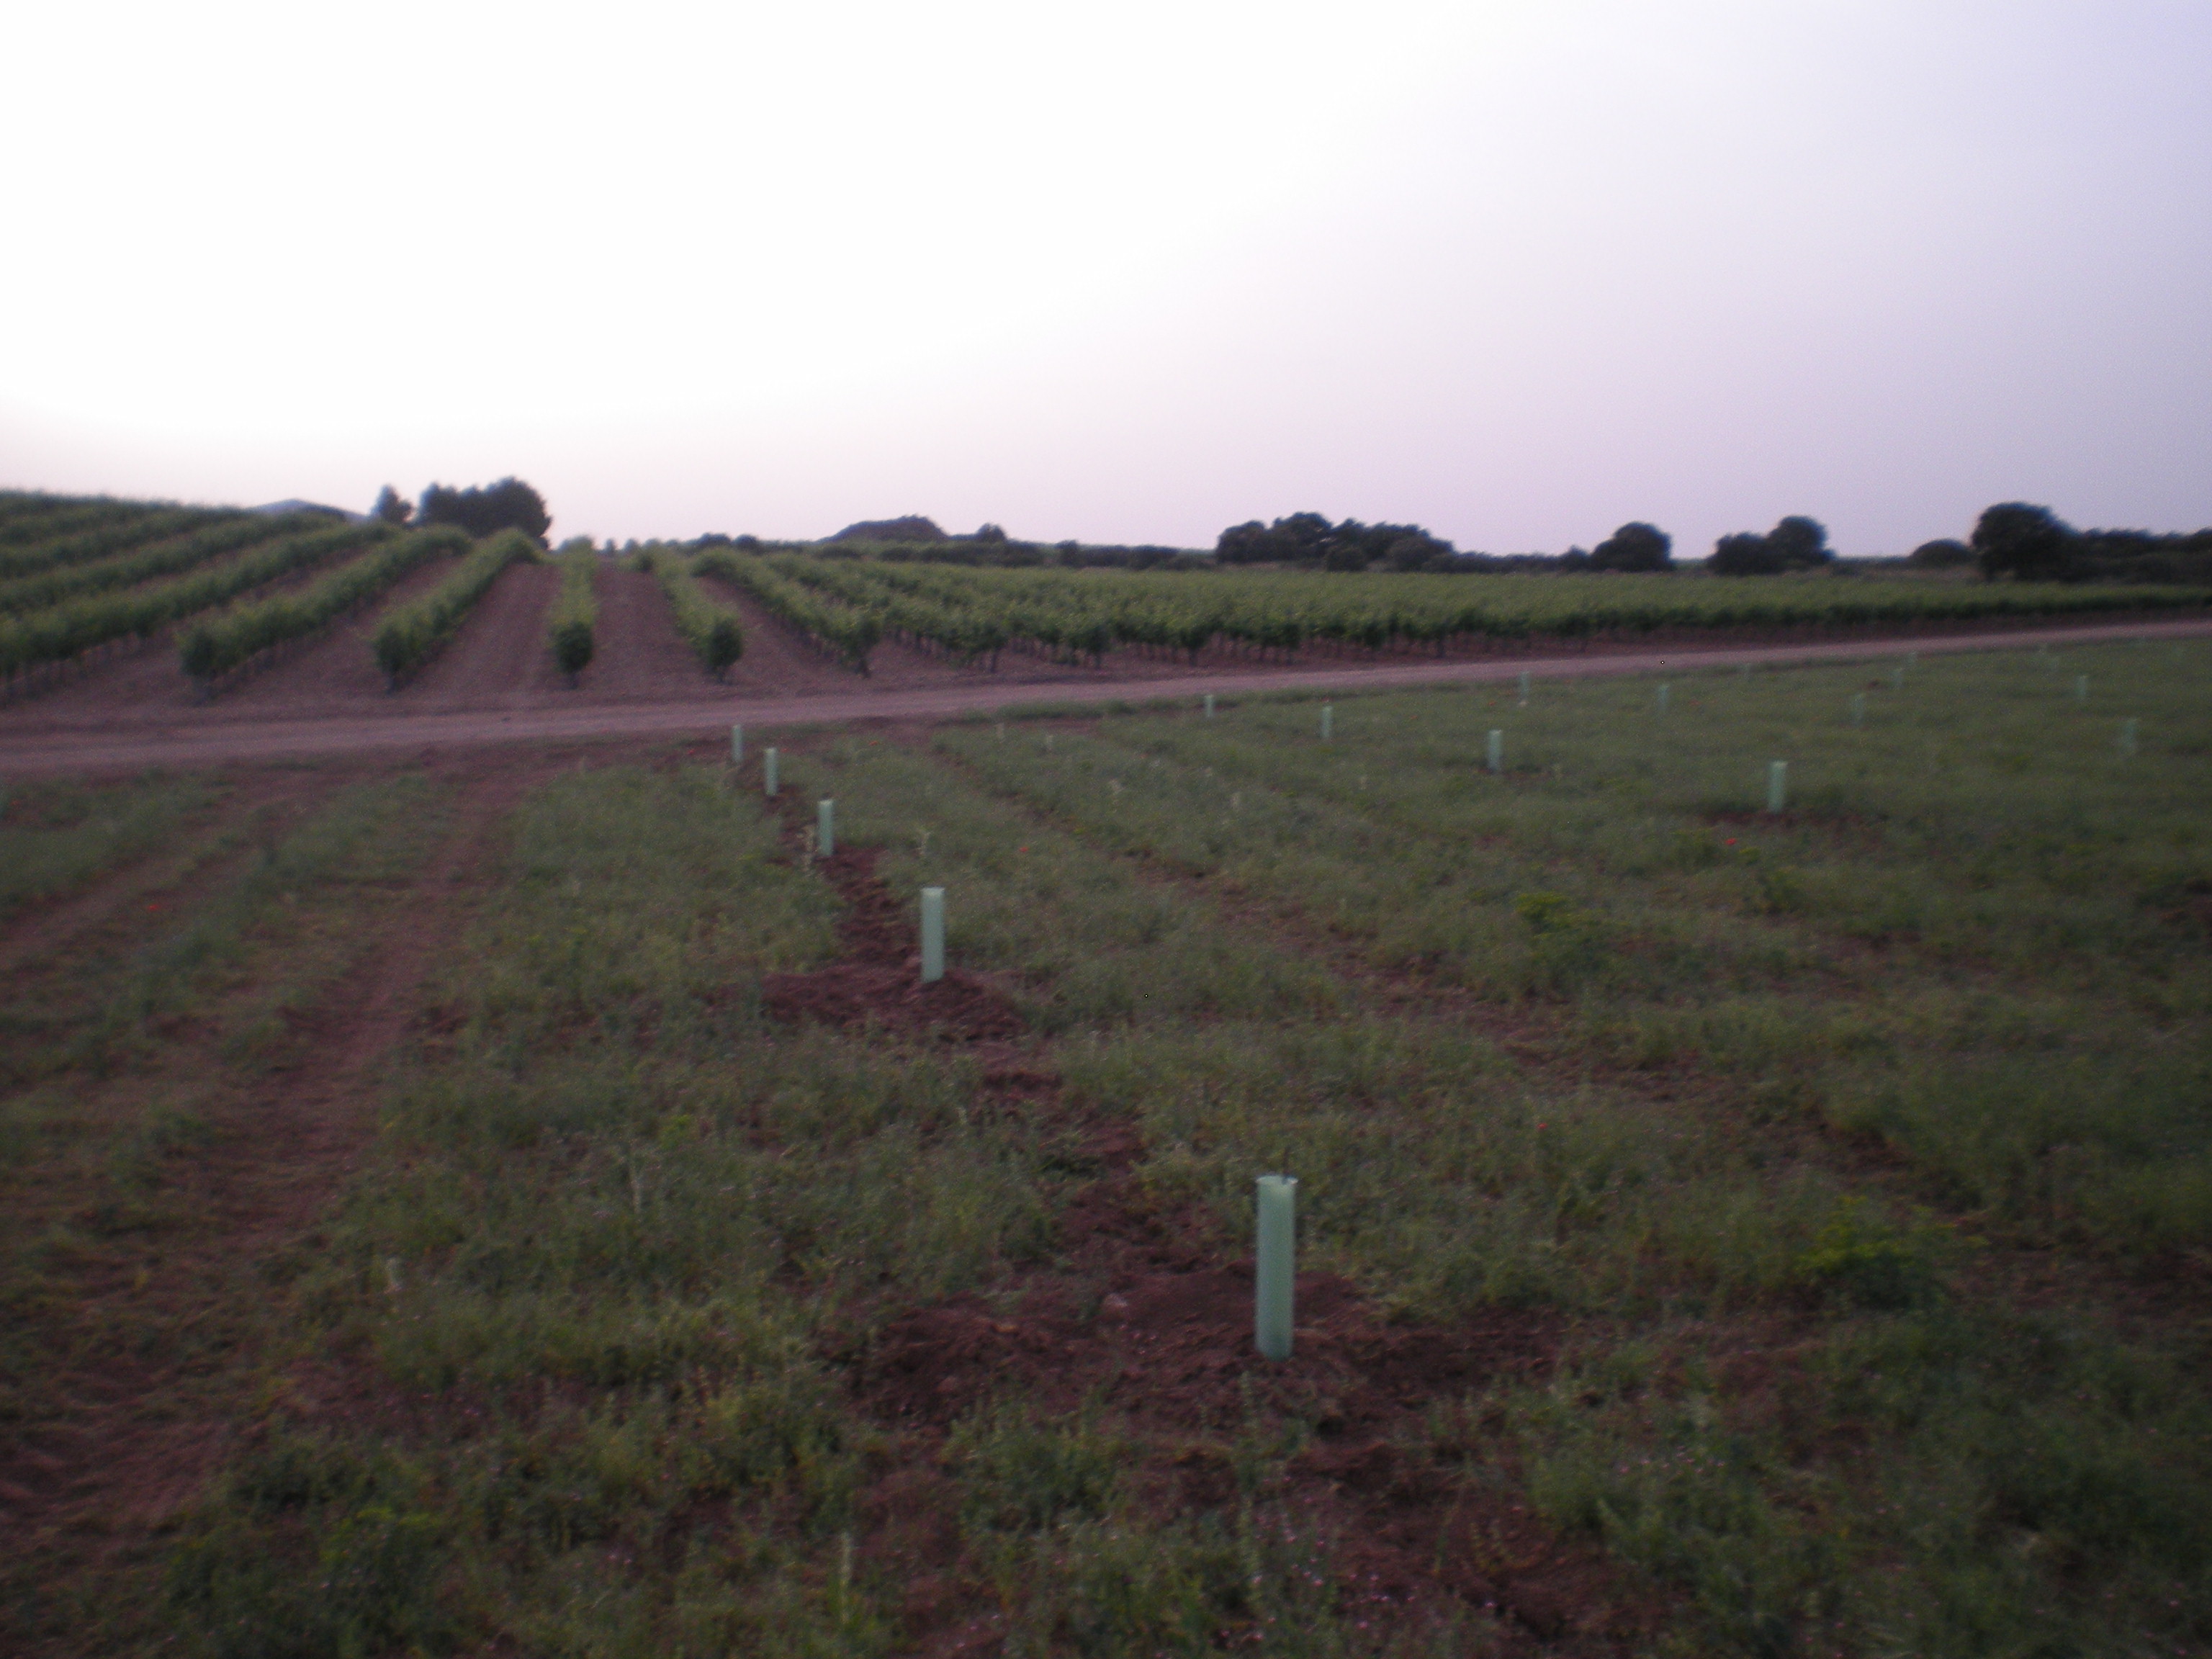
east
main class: Cropland
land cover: Nuts trees
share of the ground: < 10 %
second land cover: Spontaneously vegetated surfaces
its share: 50 - 75 %
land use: Agriculture (excluding fallow land and kitchen gardens)
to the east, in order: Nuts trees; Spontaneously vegetated surfaces; Grass margins; Tracks; Grass margins; Vineyards
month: May
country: ES
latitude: 39.0670
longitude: -3.0137
